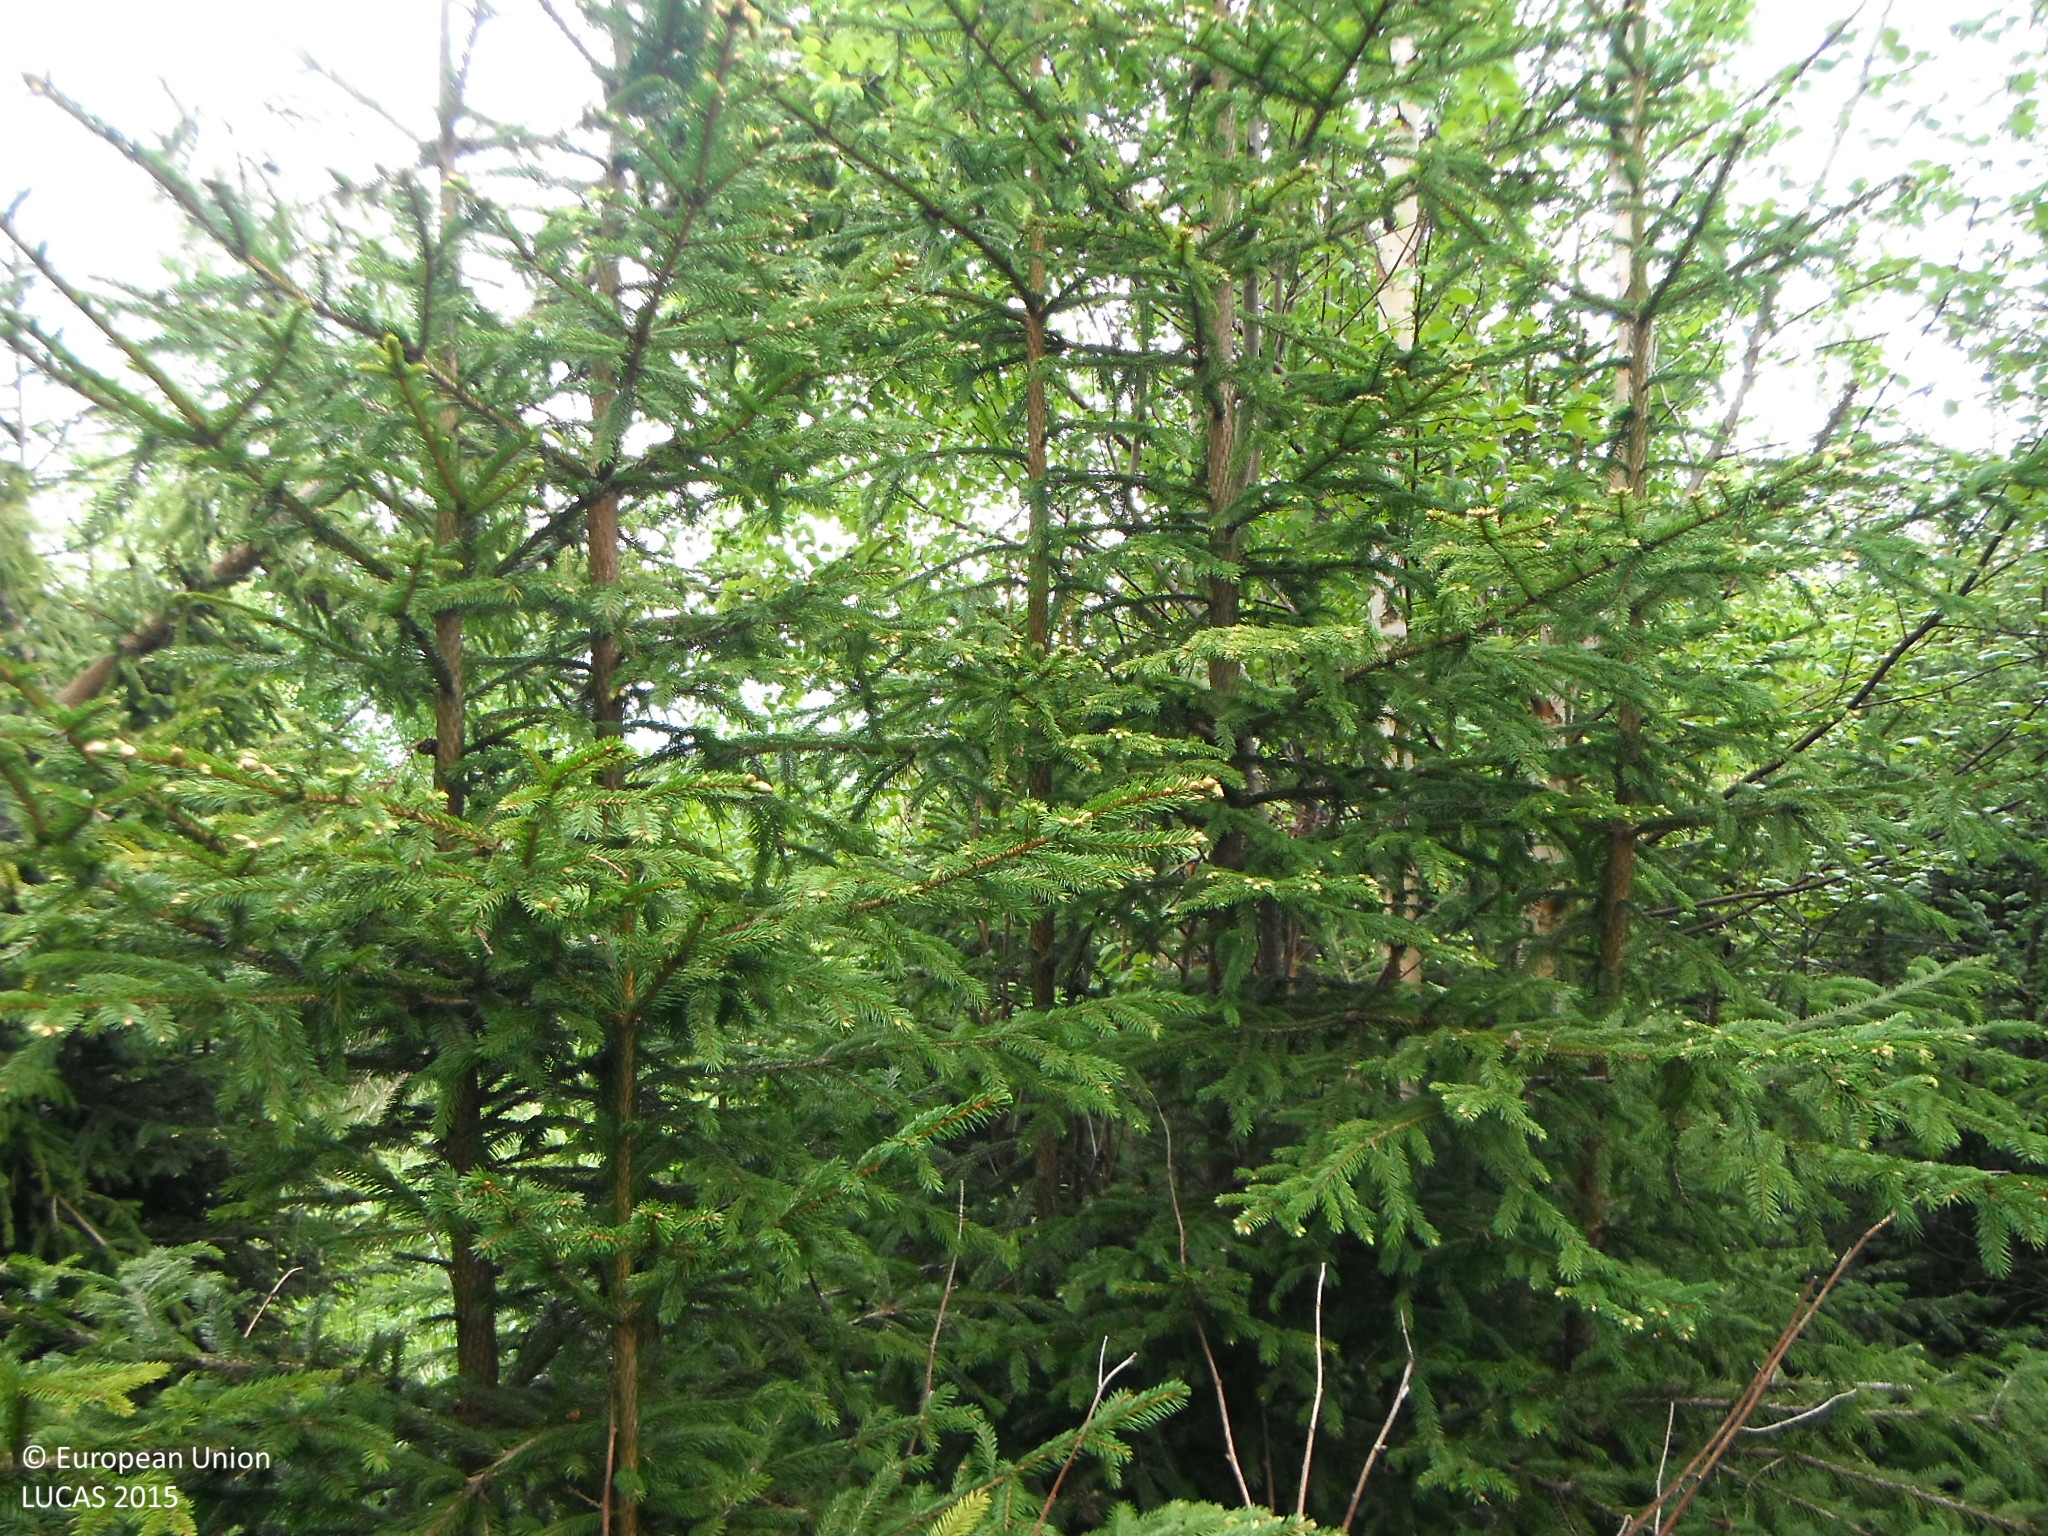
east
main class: Woodland
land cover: Spruce dominated mixed woodland
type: hemiboreal forest and nemoral coniferous forest and mixed broadleaved-coniferous forest
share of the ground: > 75 %
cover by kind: coniferous forest trees 65 %, broadleaved forest trees 35 %
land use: Forestry
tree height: > 5 m
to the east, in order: Spruce dominated mixed woodland; Spontaneously vegetated surfaces; Tracks; Shrubland with sparse tree cover; Paved roads, cycling and walking lanes; Spruce dominated mixed woodland
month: May
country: SK
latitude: 49.1413
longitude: 20.2458
